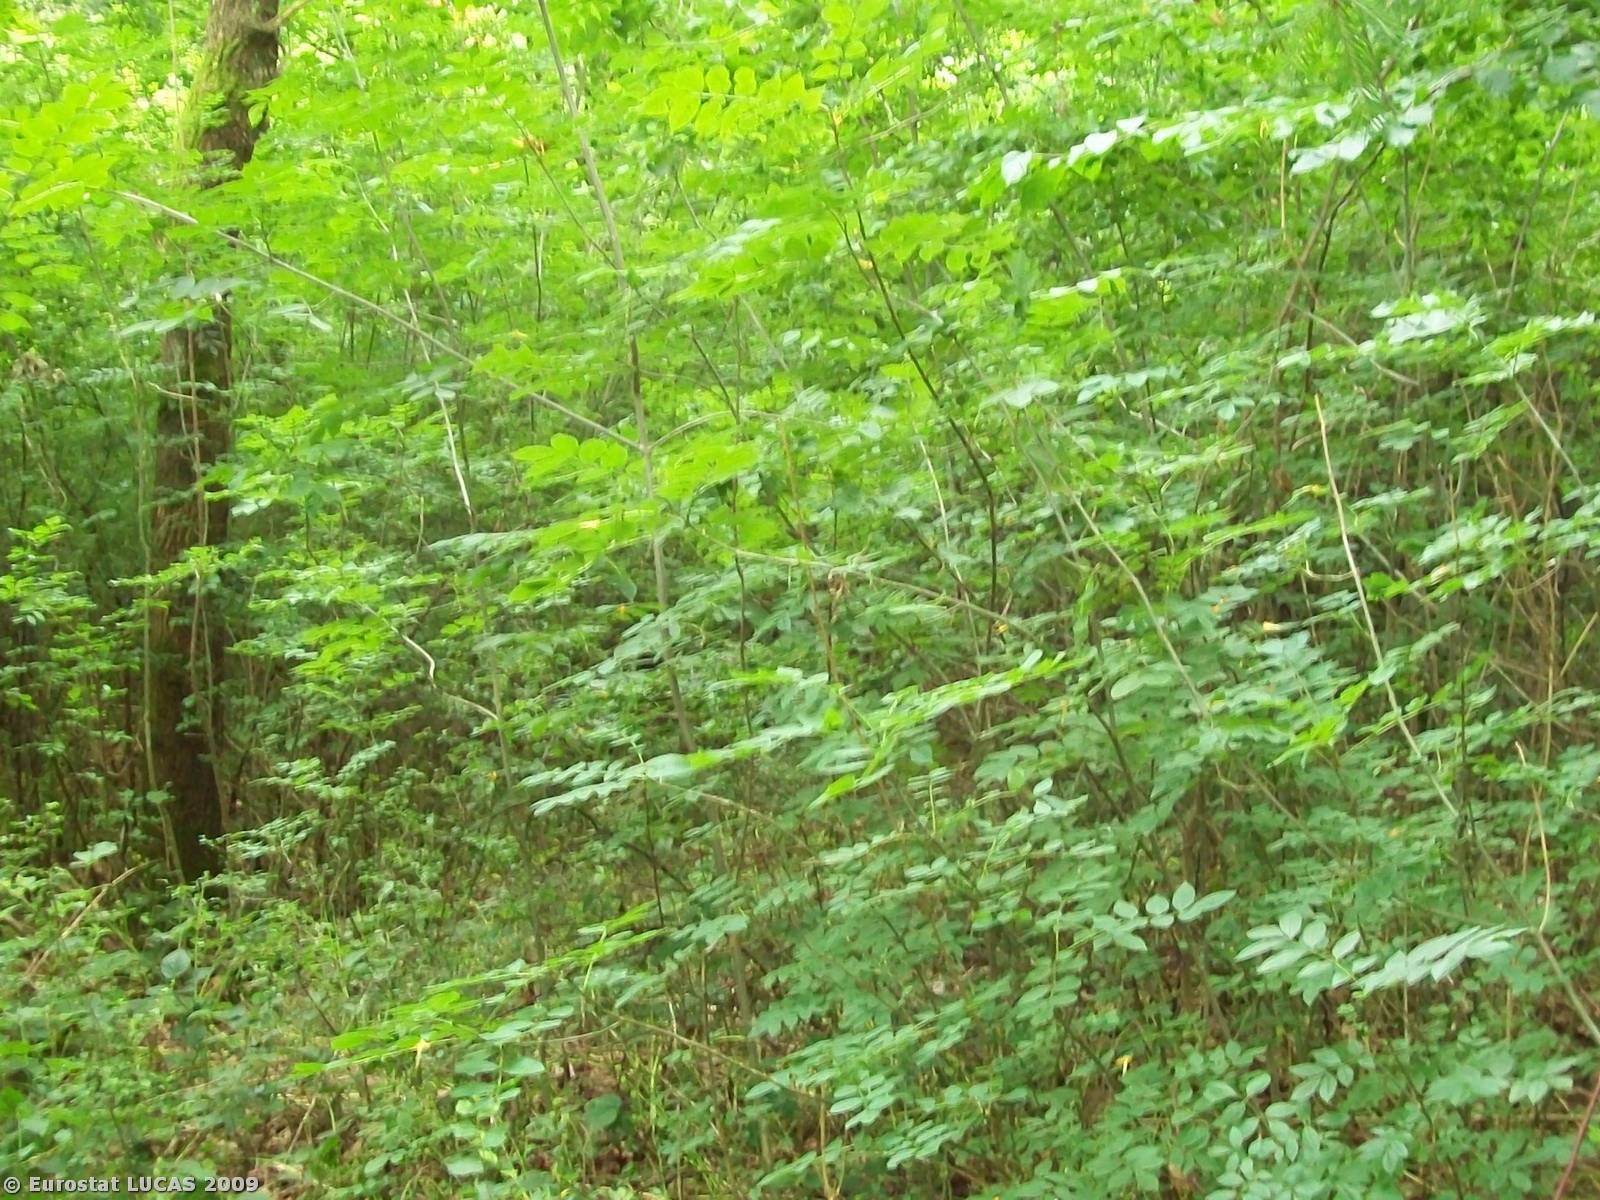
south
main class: Woodland
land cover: Broadleaved woodland
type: mesophytic deciduous forest
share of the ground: > 75 %
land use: Forestry
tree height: > 5 m
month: June
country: GB
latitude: 51.3429
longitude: -2.2215
